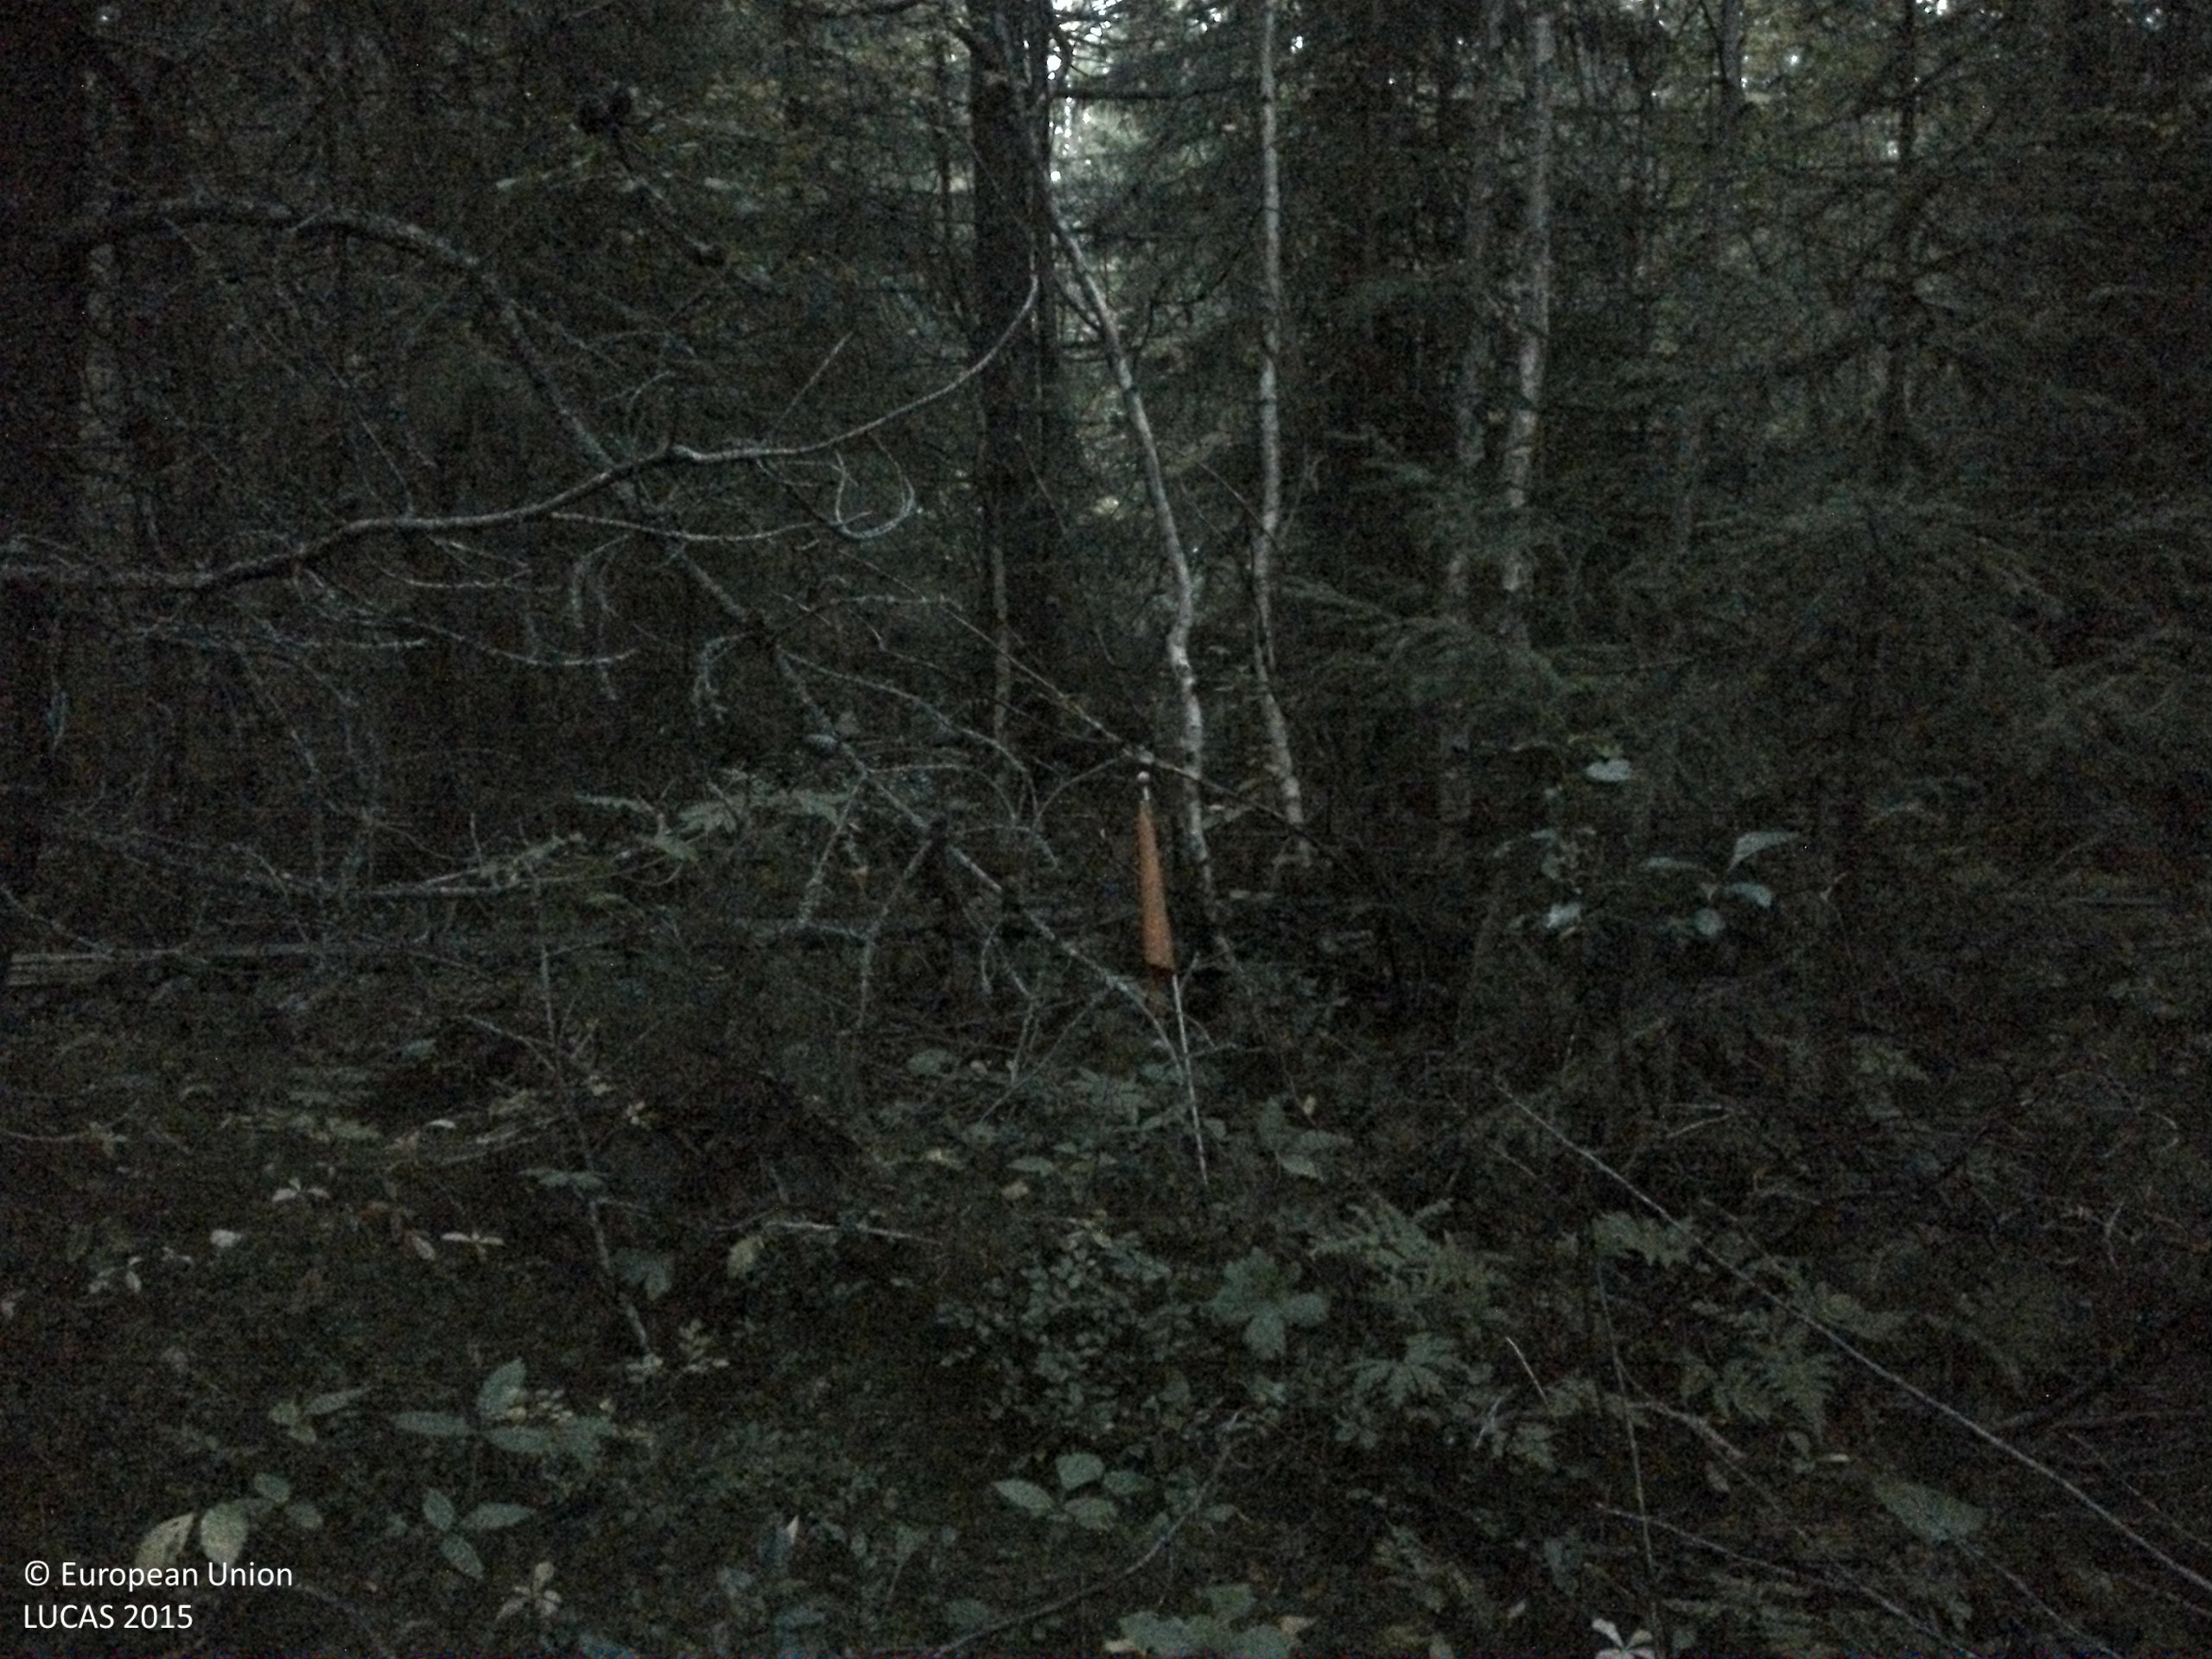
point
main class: Woodland
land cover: Pine dominated coniferous woodland
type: exotic forest
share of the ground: > 75 %
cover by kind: coniferous forest trees 70 %, broadleaved forest trees 10 %, shrubs 10 %, lichens and mosses 10 %
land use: Forestry
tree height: > 5 m
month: September
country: SE
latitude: 63.9149
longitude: 16.6368
